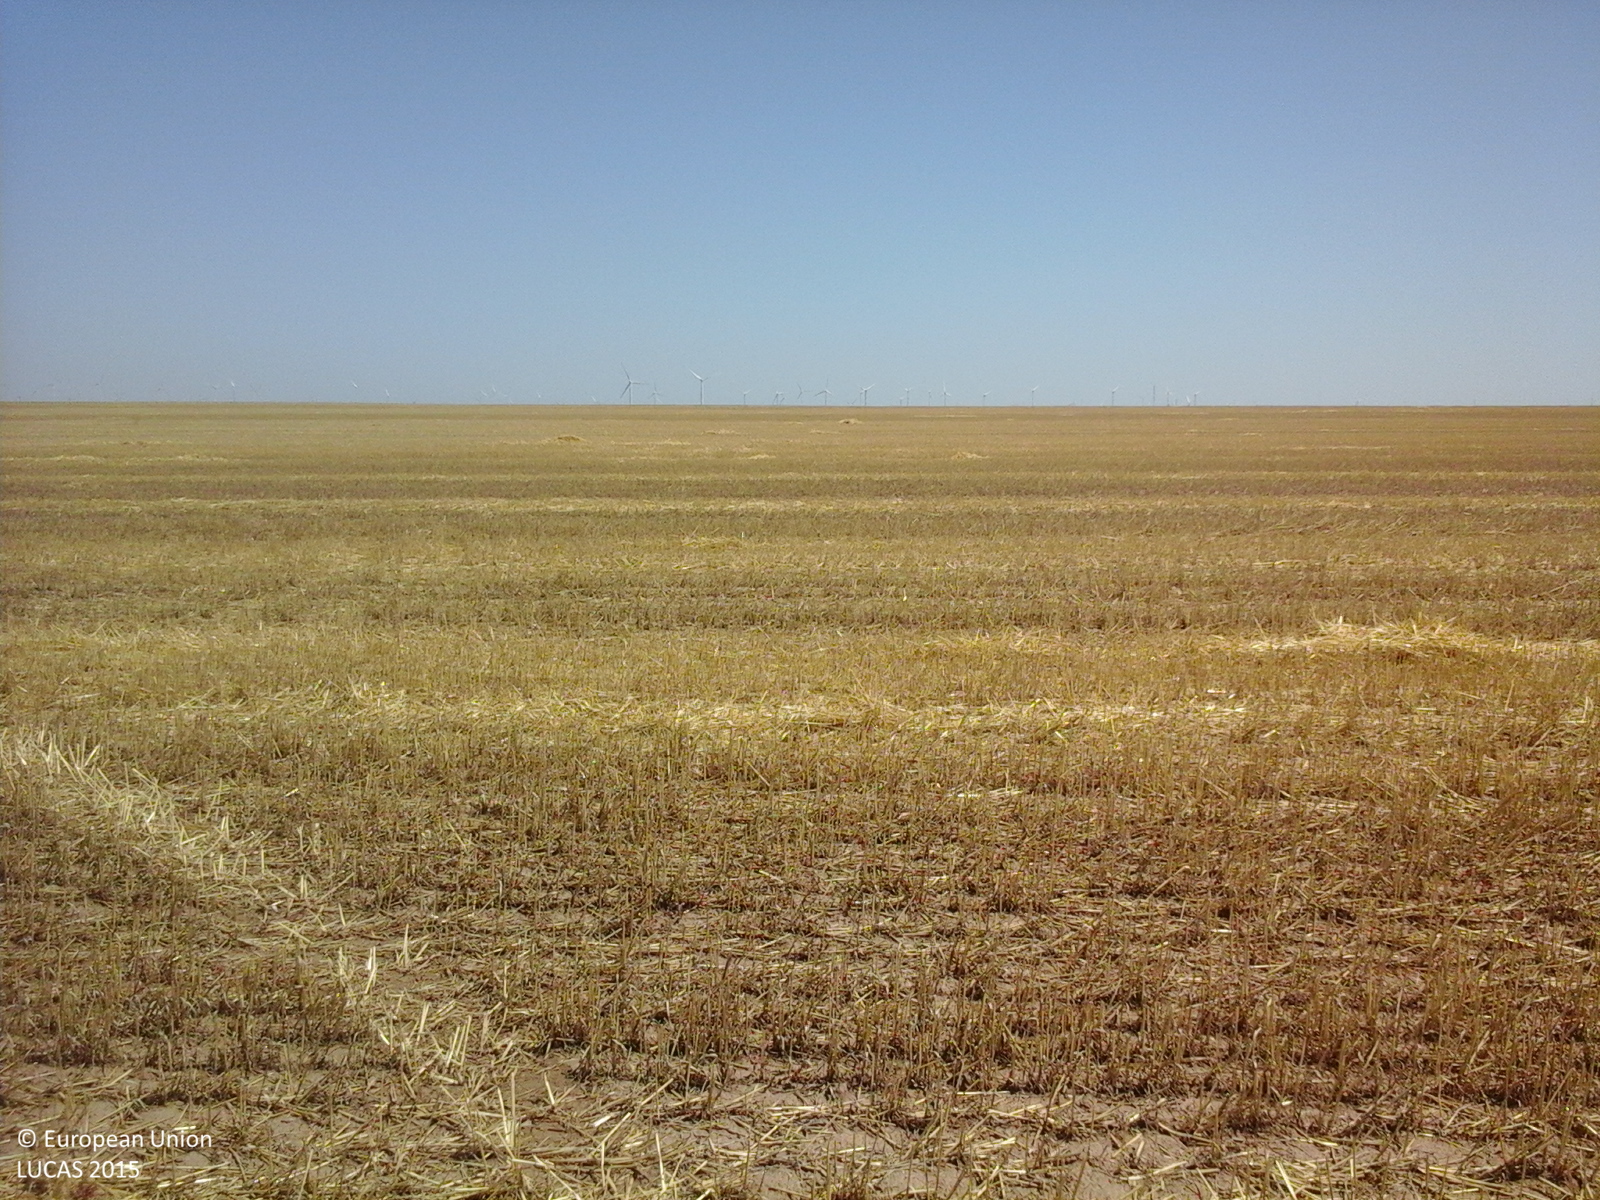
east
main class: Cropland
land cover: Common wheat
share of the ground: 50 - 75 %
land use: Agriculture (excluding fallow land and kitchen gardens)
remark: Harvested field
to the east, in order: Common wheat
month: August
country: RO
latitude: 44.4721
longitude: 28.2292
